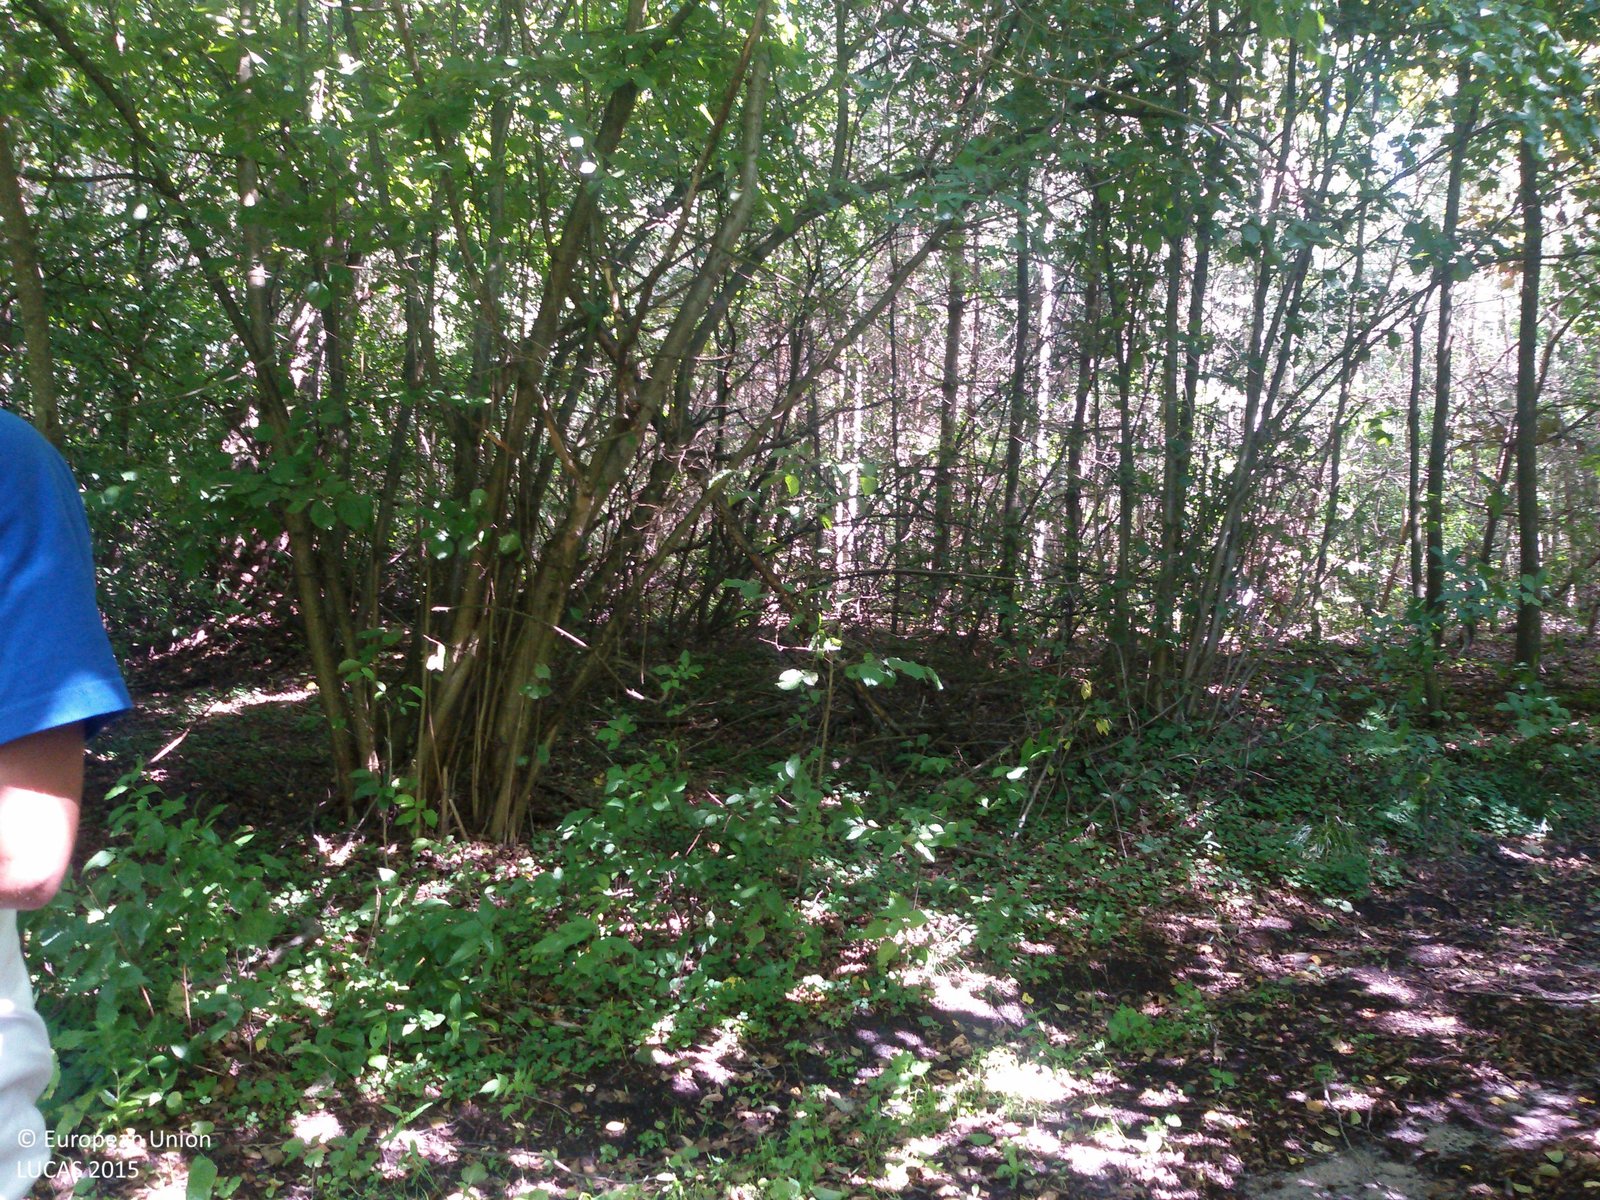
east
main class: Woodland
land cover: Broadleaved woodland
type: mesophytic deciduous forest
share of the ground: > 75 %
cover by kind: broadleaved forest trees 75 %, herbaceous plants 15 %, shrubs 10 %
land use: Forestry
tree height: > 5 m
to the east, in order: Broadleaved woodland; Grass margins; Tracks; Broadleaved woodland; Tracks; Pine dominated mixed woodland; Tracks; Pine dominated mixed woodland; Ditches and canals; Pine dominated mixed woodland
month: July
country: PL
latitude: 51.5105
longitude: 23.4991
